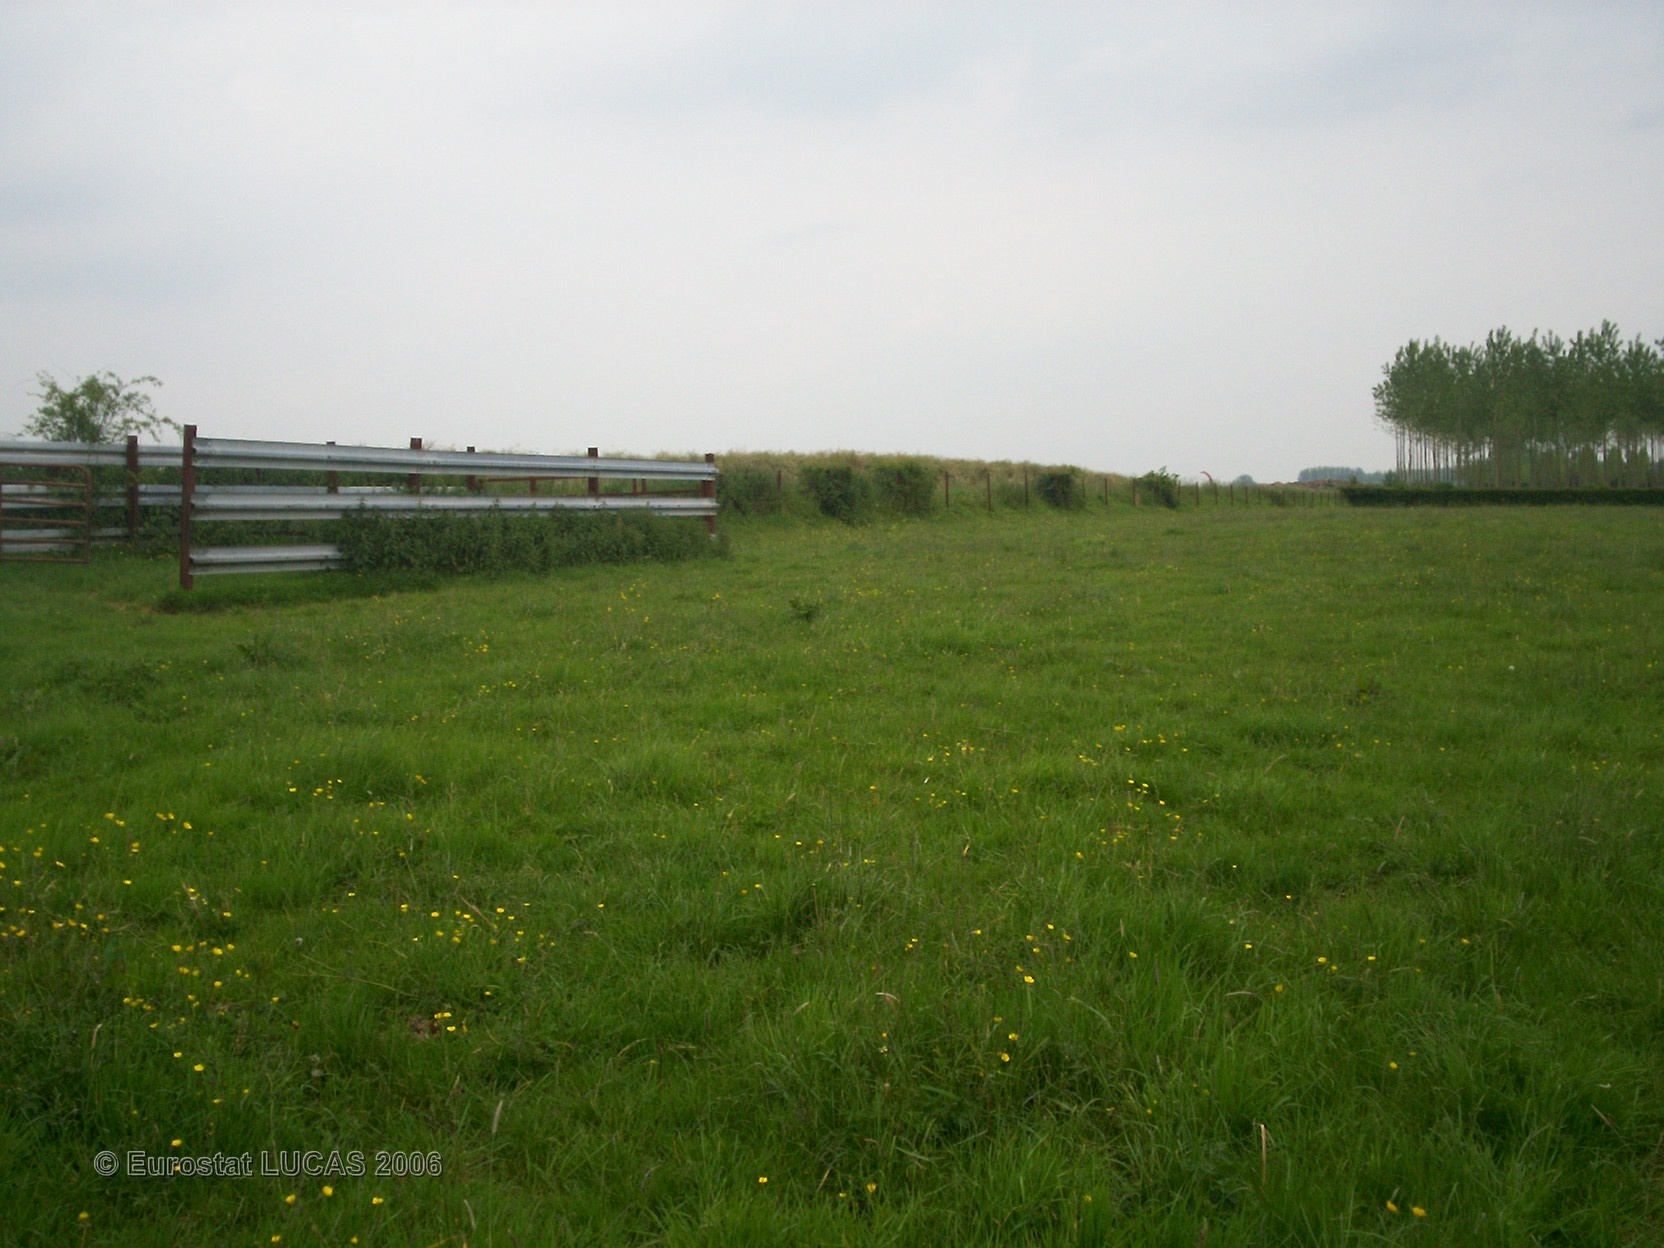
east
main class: Grassland
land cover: Grassland without tree/shrub cover
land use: Agriculture (excluding fallow land and kitchen gardens)
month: June
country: FR
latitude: 50.3160
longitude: 3.6875
